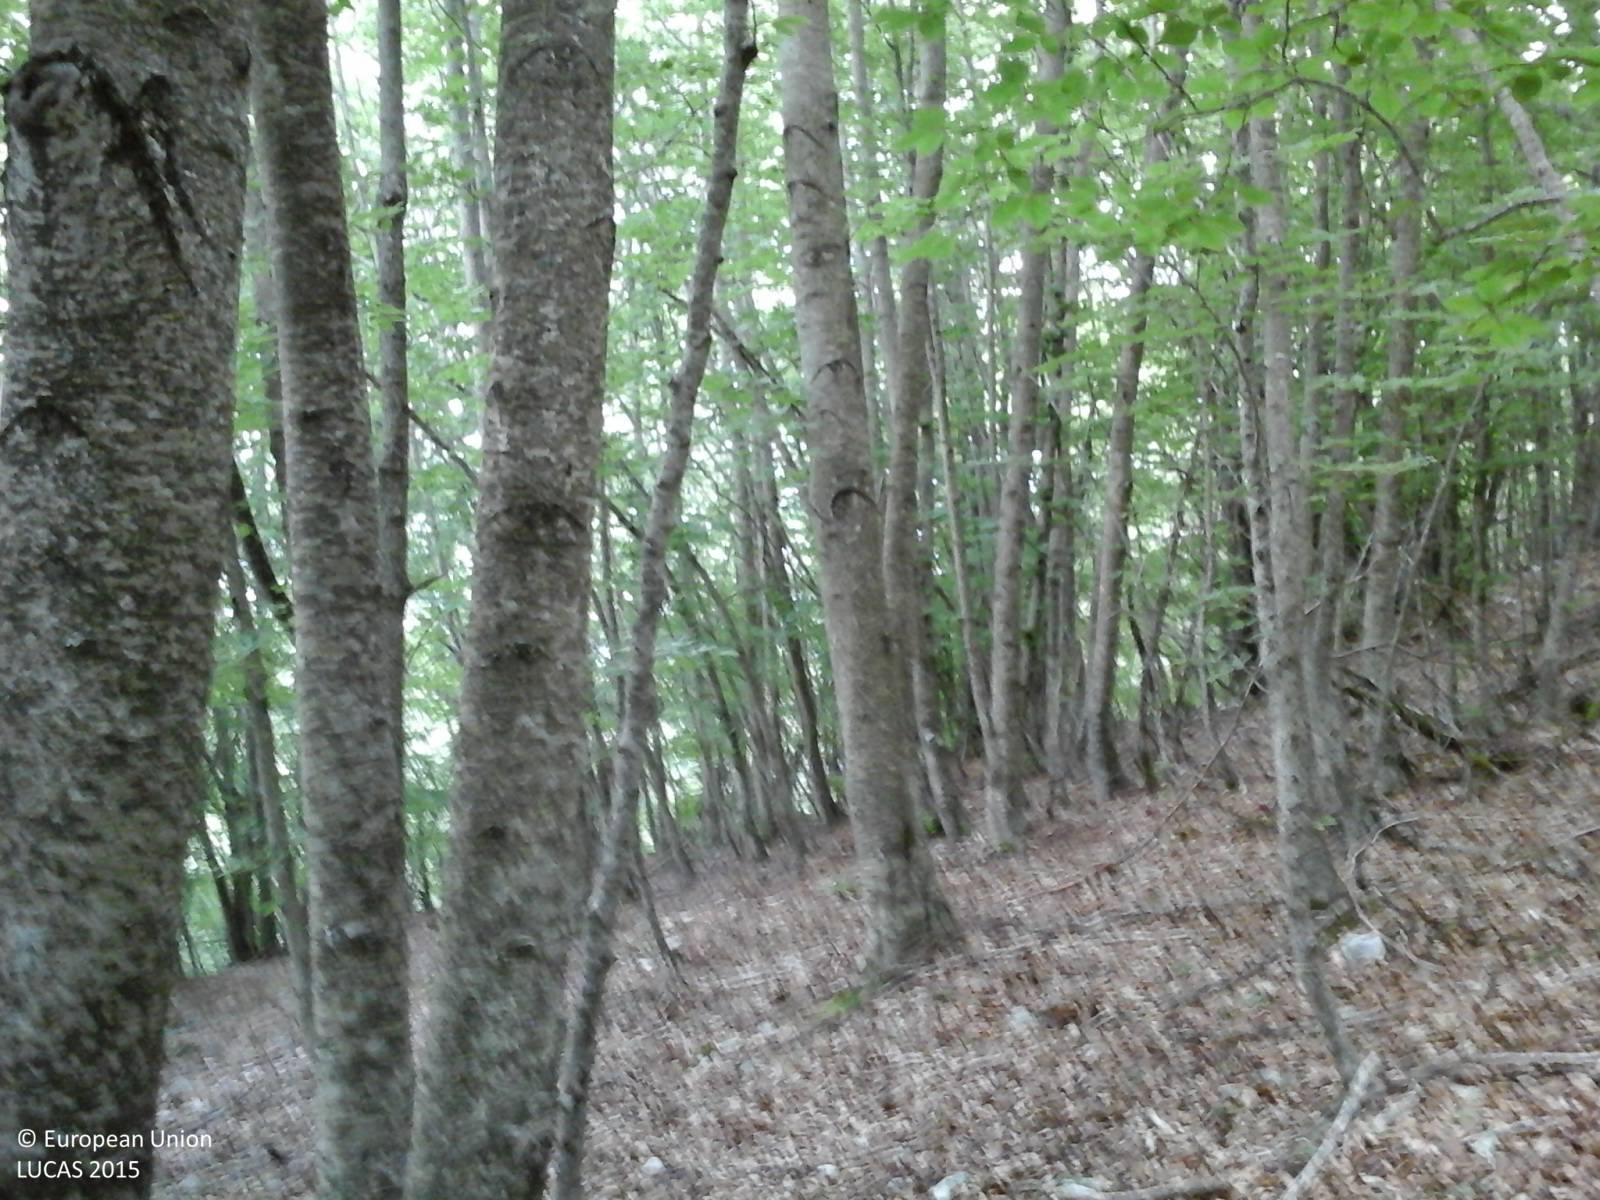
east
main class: Woodland
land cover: Broadleaved woodland
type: mountainous beech forest
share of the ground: > 75 %
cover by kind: broadleaved forest trees 100 %
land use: Forestry
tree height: > 5 m
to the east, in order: Broadleaved woodland; Tracks; Broadleaved woodland; Shrubland without tree cover
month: June
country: IT
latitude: 41.7444
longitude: 13.9662
